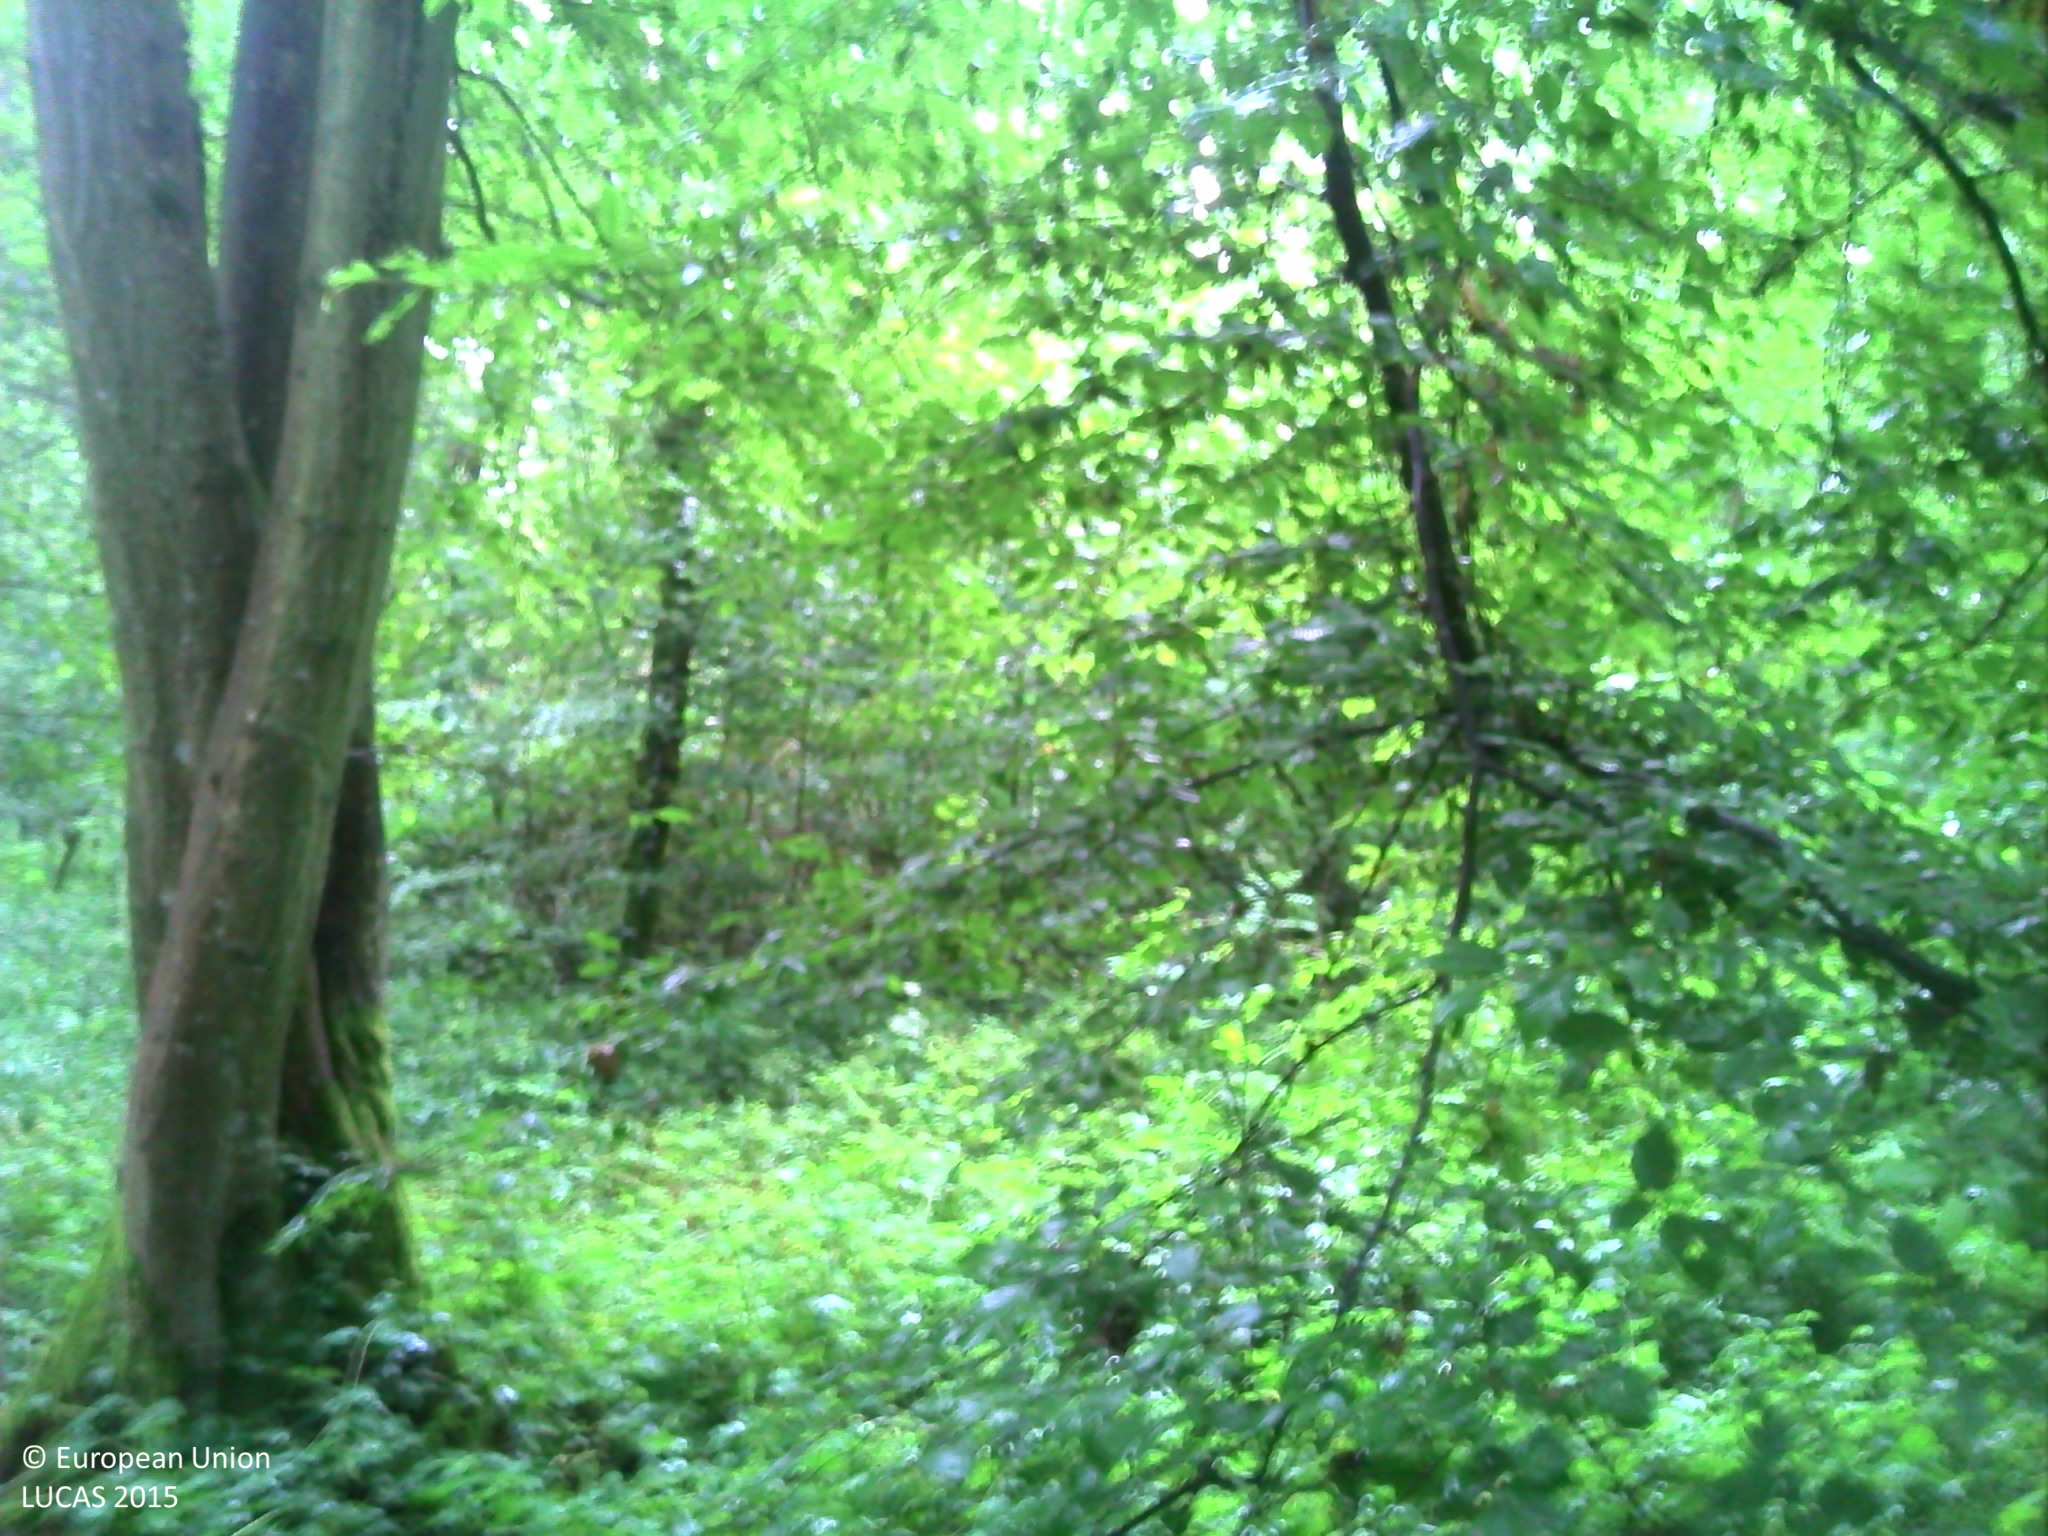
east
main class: Woodland
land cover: Broadleaved woodland
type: mesophytic deciduous forest
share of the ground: > 75 %
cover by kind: broadleaved forest trees 95 %, herbaceous plants 5 %
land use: Forestry
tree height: > 5 m
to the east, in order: Broadleaved woodland; Ditches and canals; Broadleaved woodland; Ditches and canals; Tracks; Broadleaved woodland; Ditches and canals; Maize
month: June
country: FR
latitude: 48.3579
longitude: 7.5312
